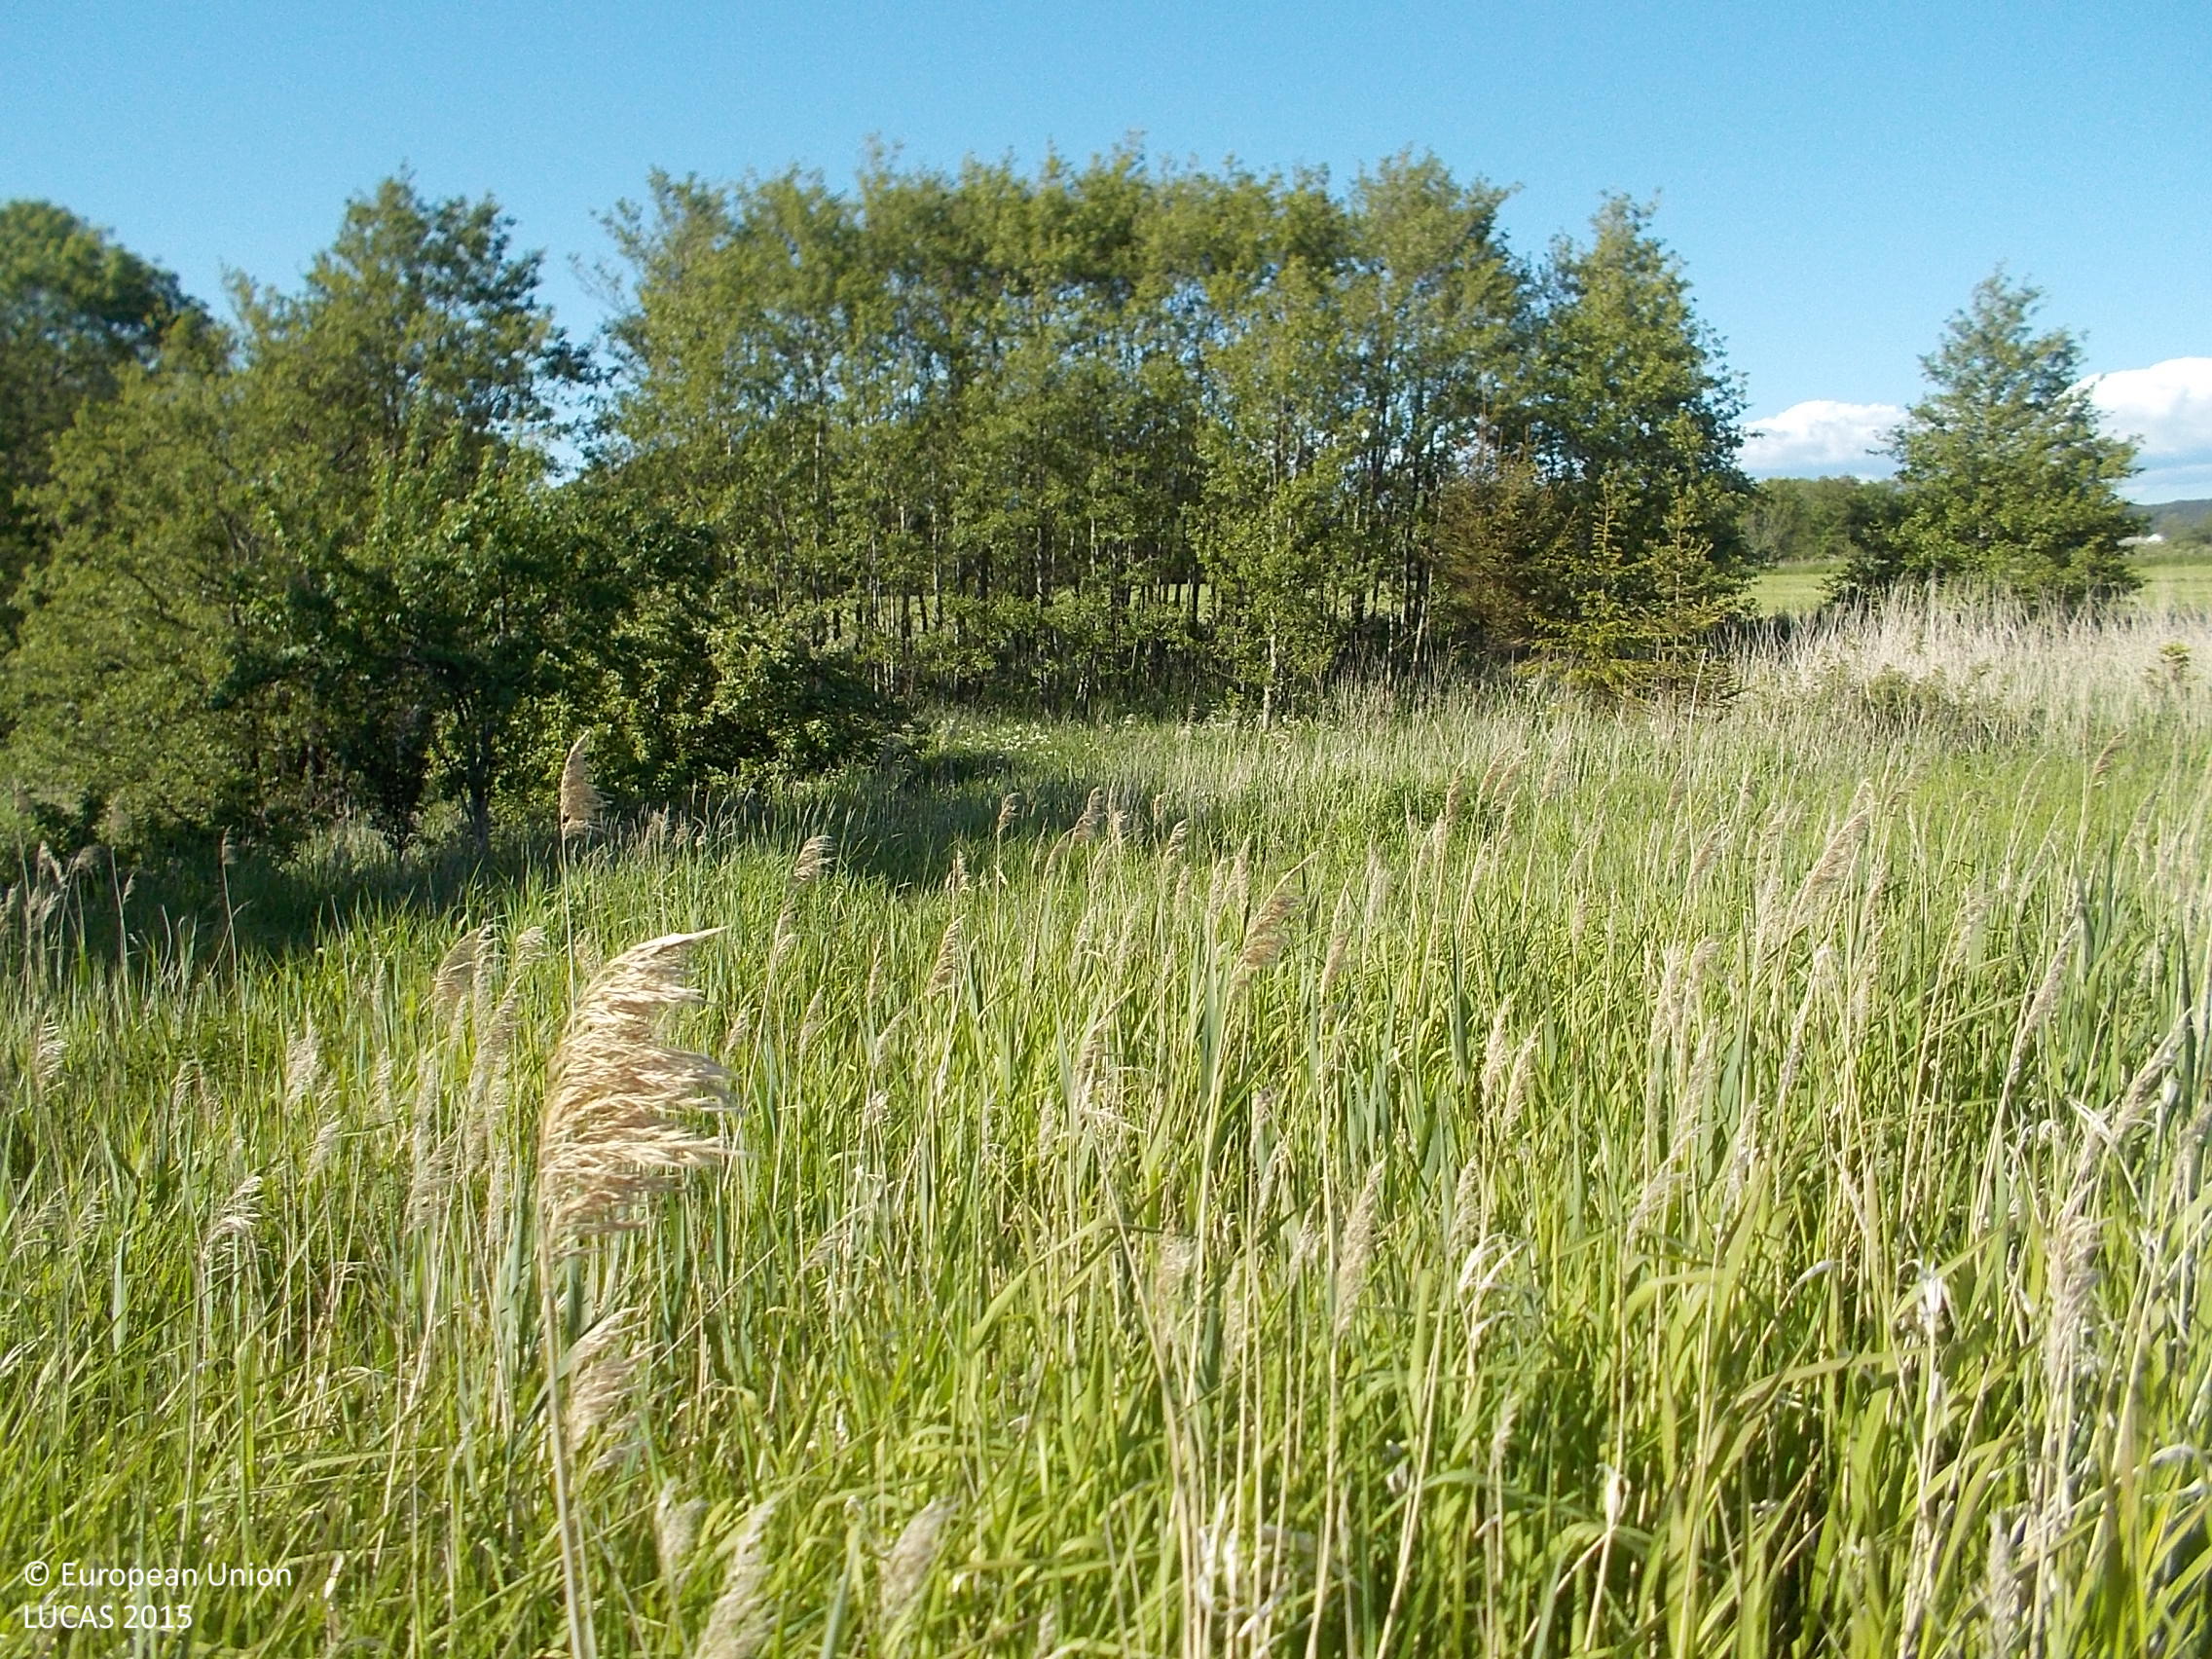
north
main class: Grassland
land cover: Grassland without tree/shrub cover
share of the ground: > 75 %
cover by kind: herbaceous plants 100 %
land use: Agriculture (excluding fallow land and kitchen gardens)
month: June
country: SE
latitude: 57.3384
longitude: 12.1732
